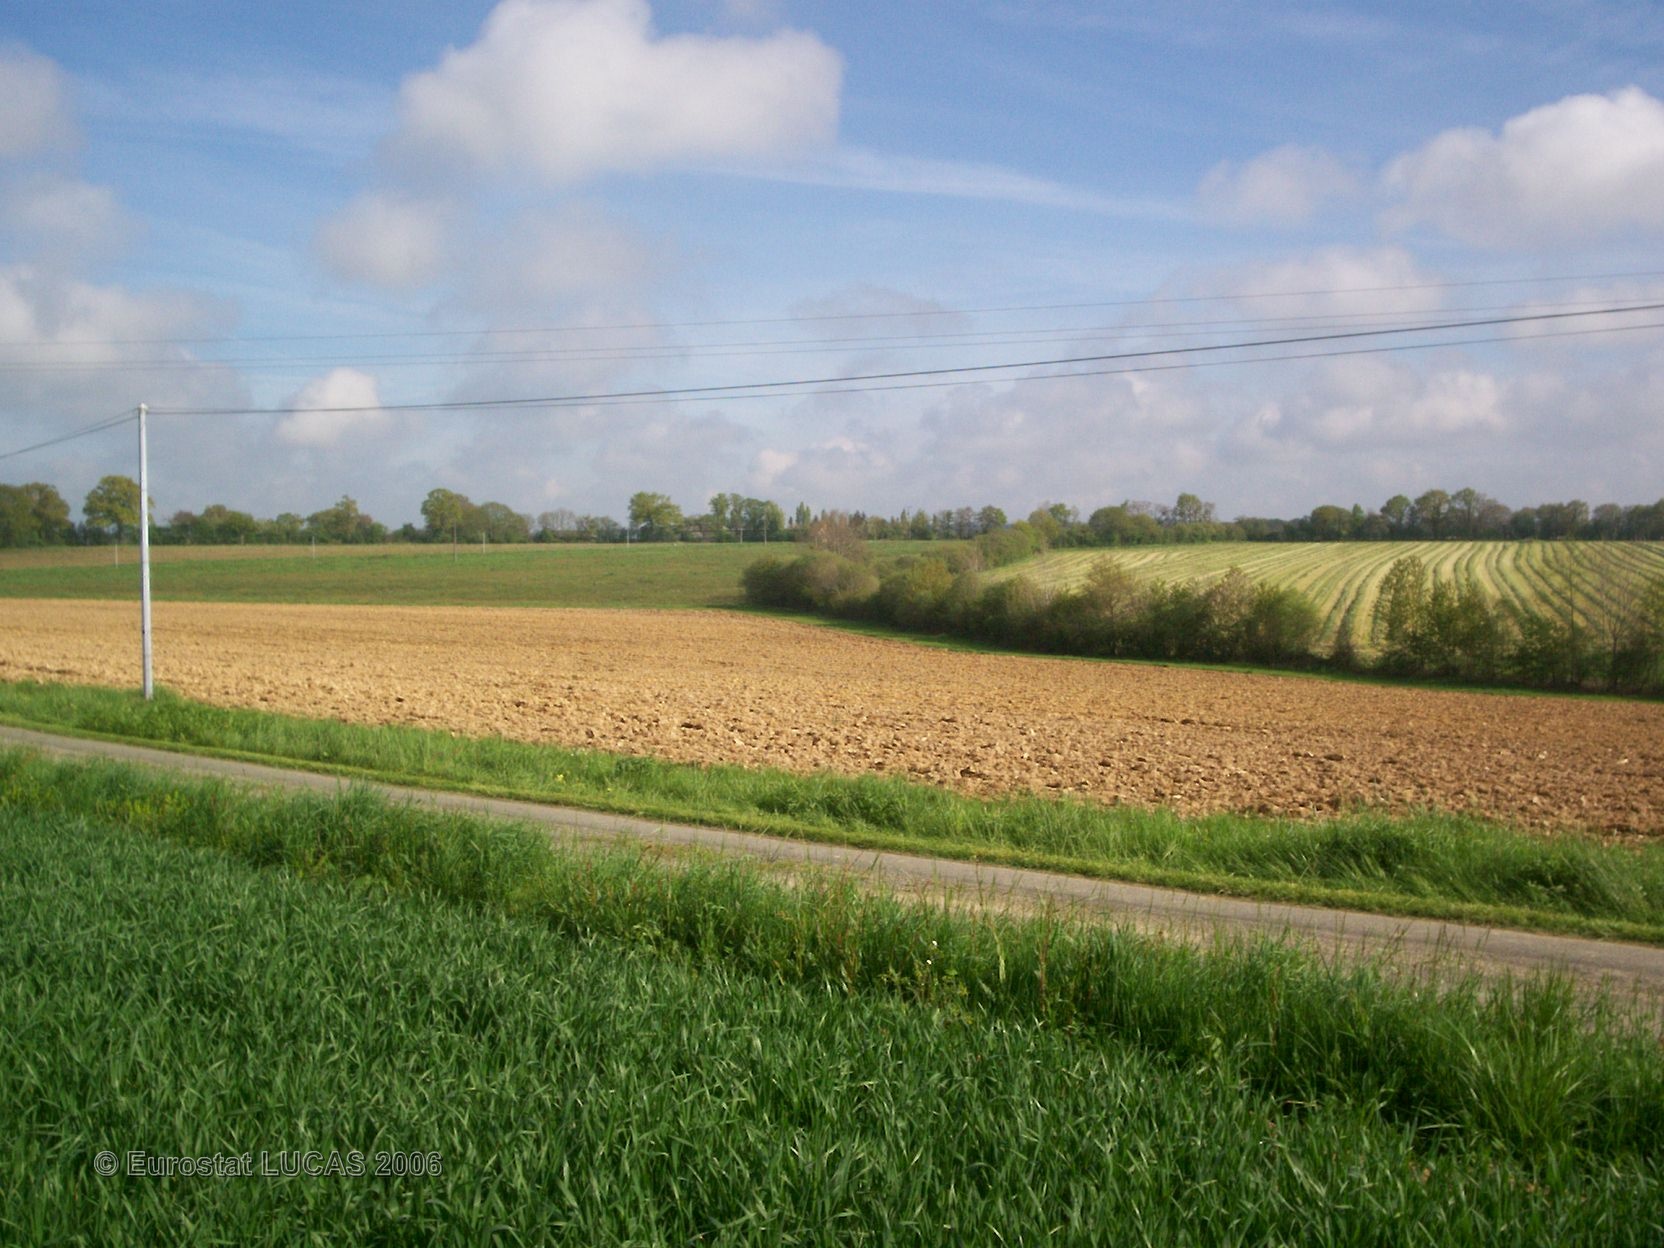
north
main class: Cropland
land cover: Common wheat
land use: Agriculture (excluding fallow land and kitchen gardens)
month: May
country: FR
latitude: 48.1250
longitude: -0.6353
